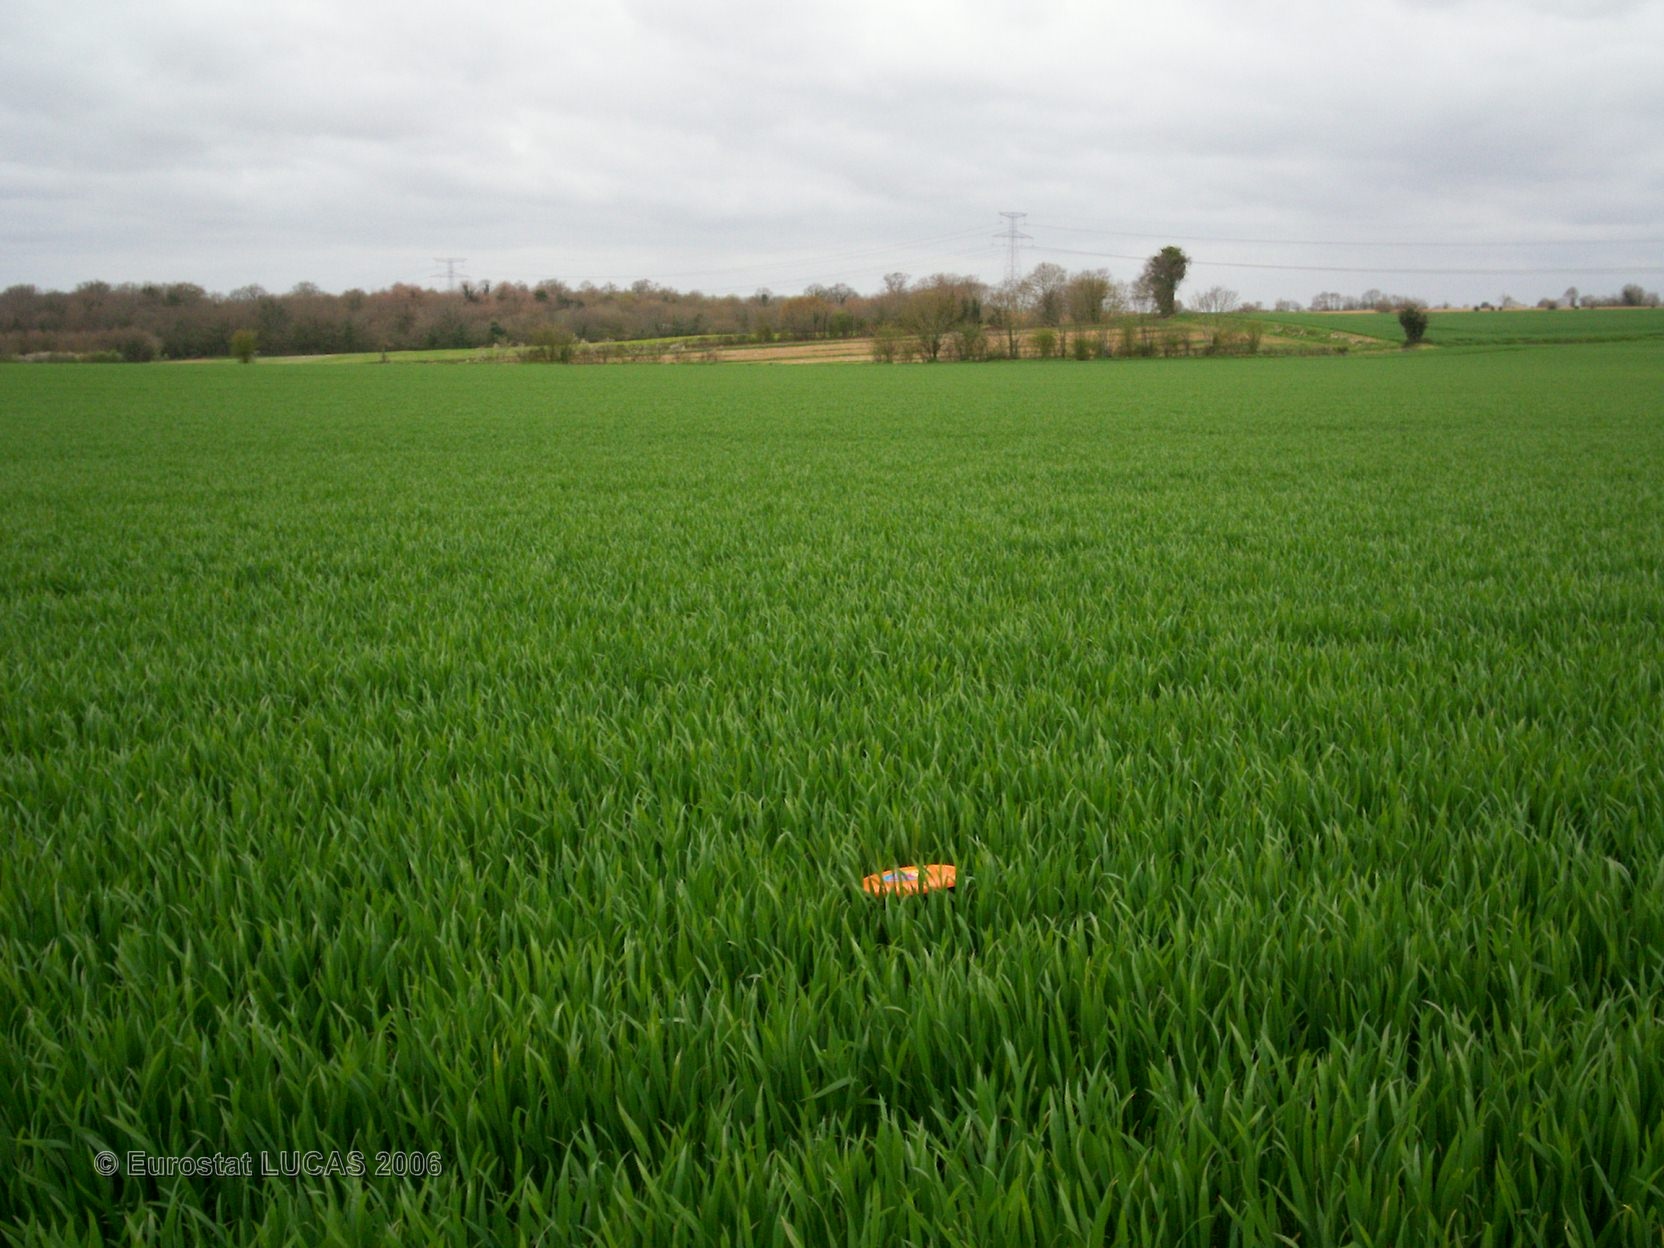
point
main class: Cropland
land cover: Common wheat
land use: Agriculture (excluding fallow land and kitchen gardens)
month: April
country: FR
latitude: 46.2788
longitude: -0.2102
